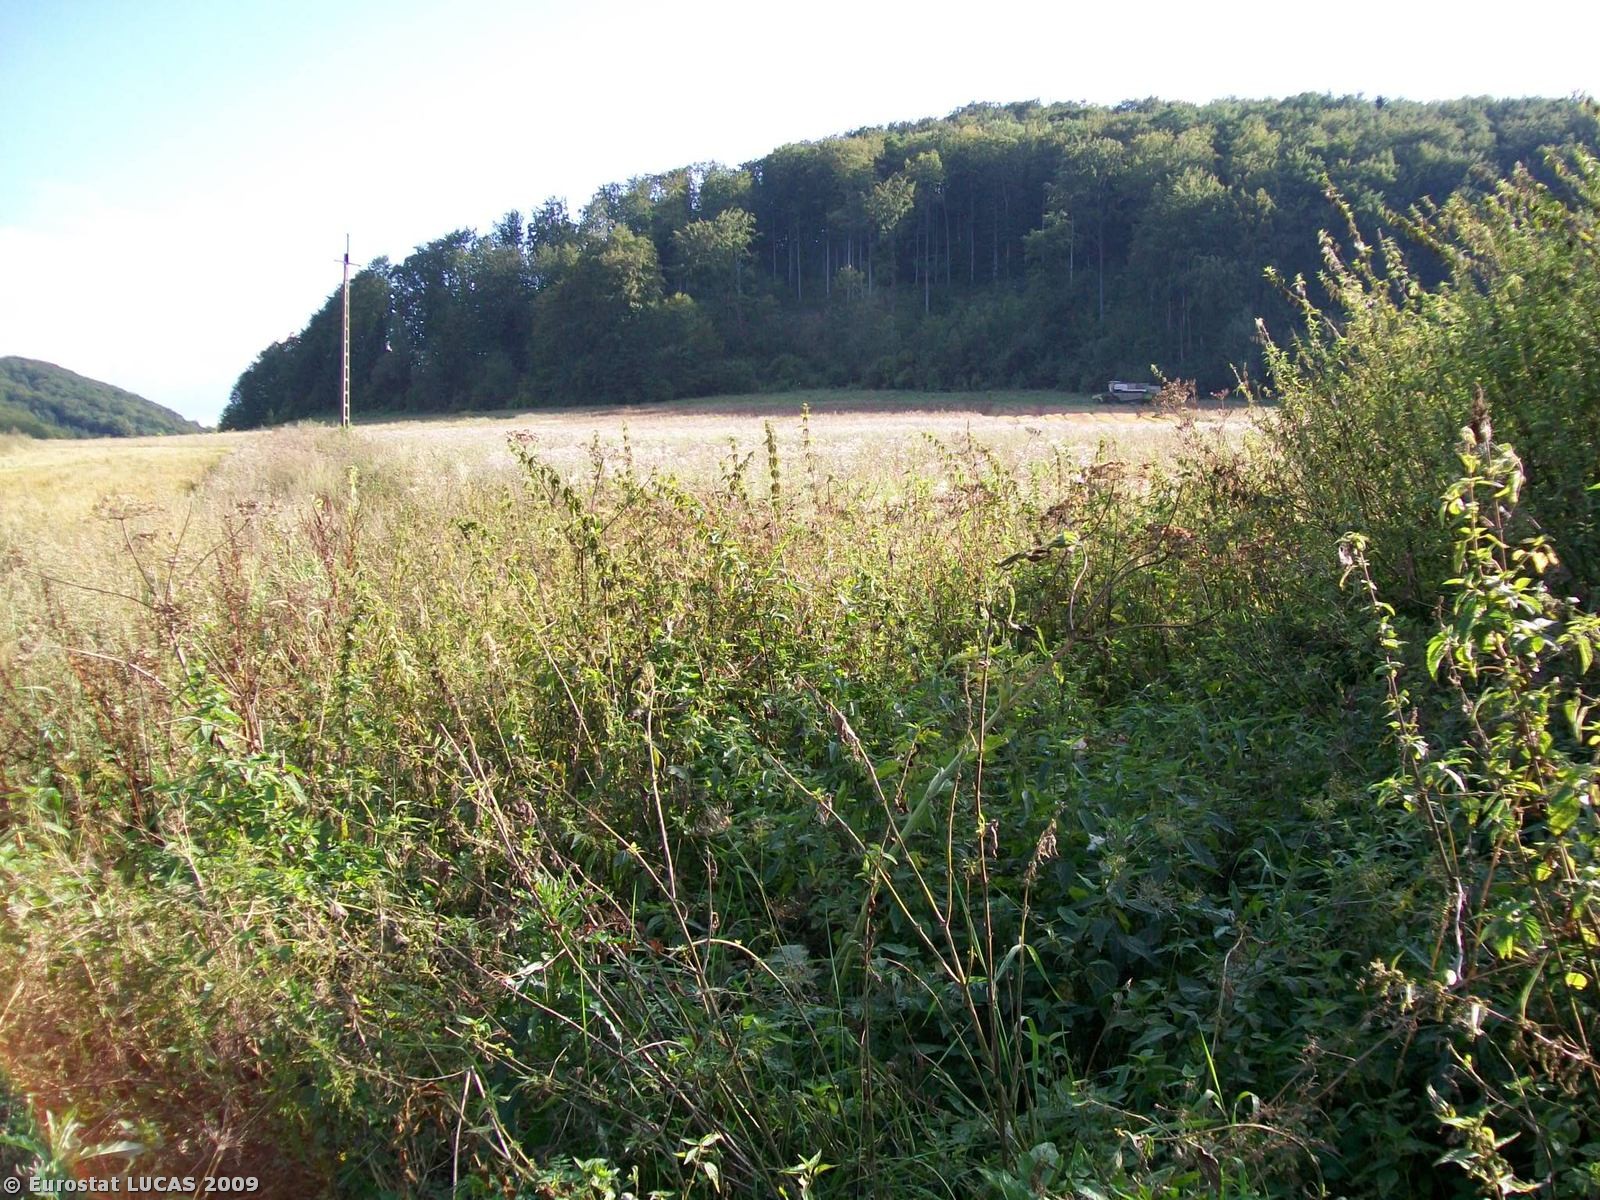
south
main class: Grassland
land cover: Spontaneously vegetated surfaces
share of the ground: > 75 %
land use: Unused
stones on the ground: < 10 %
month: September
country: PL
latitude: 50.3473
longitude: 16.7118
